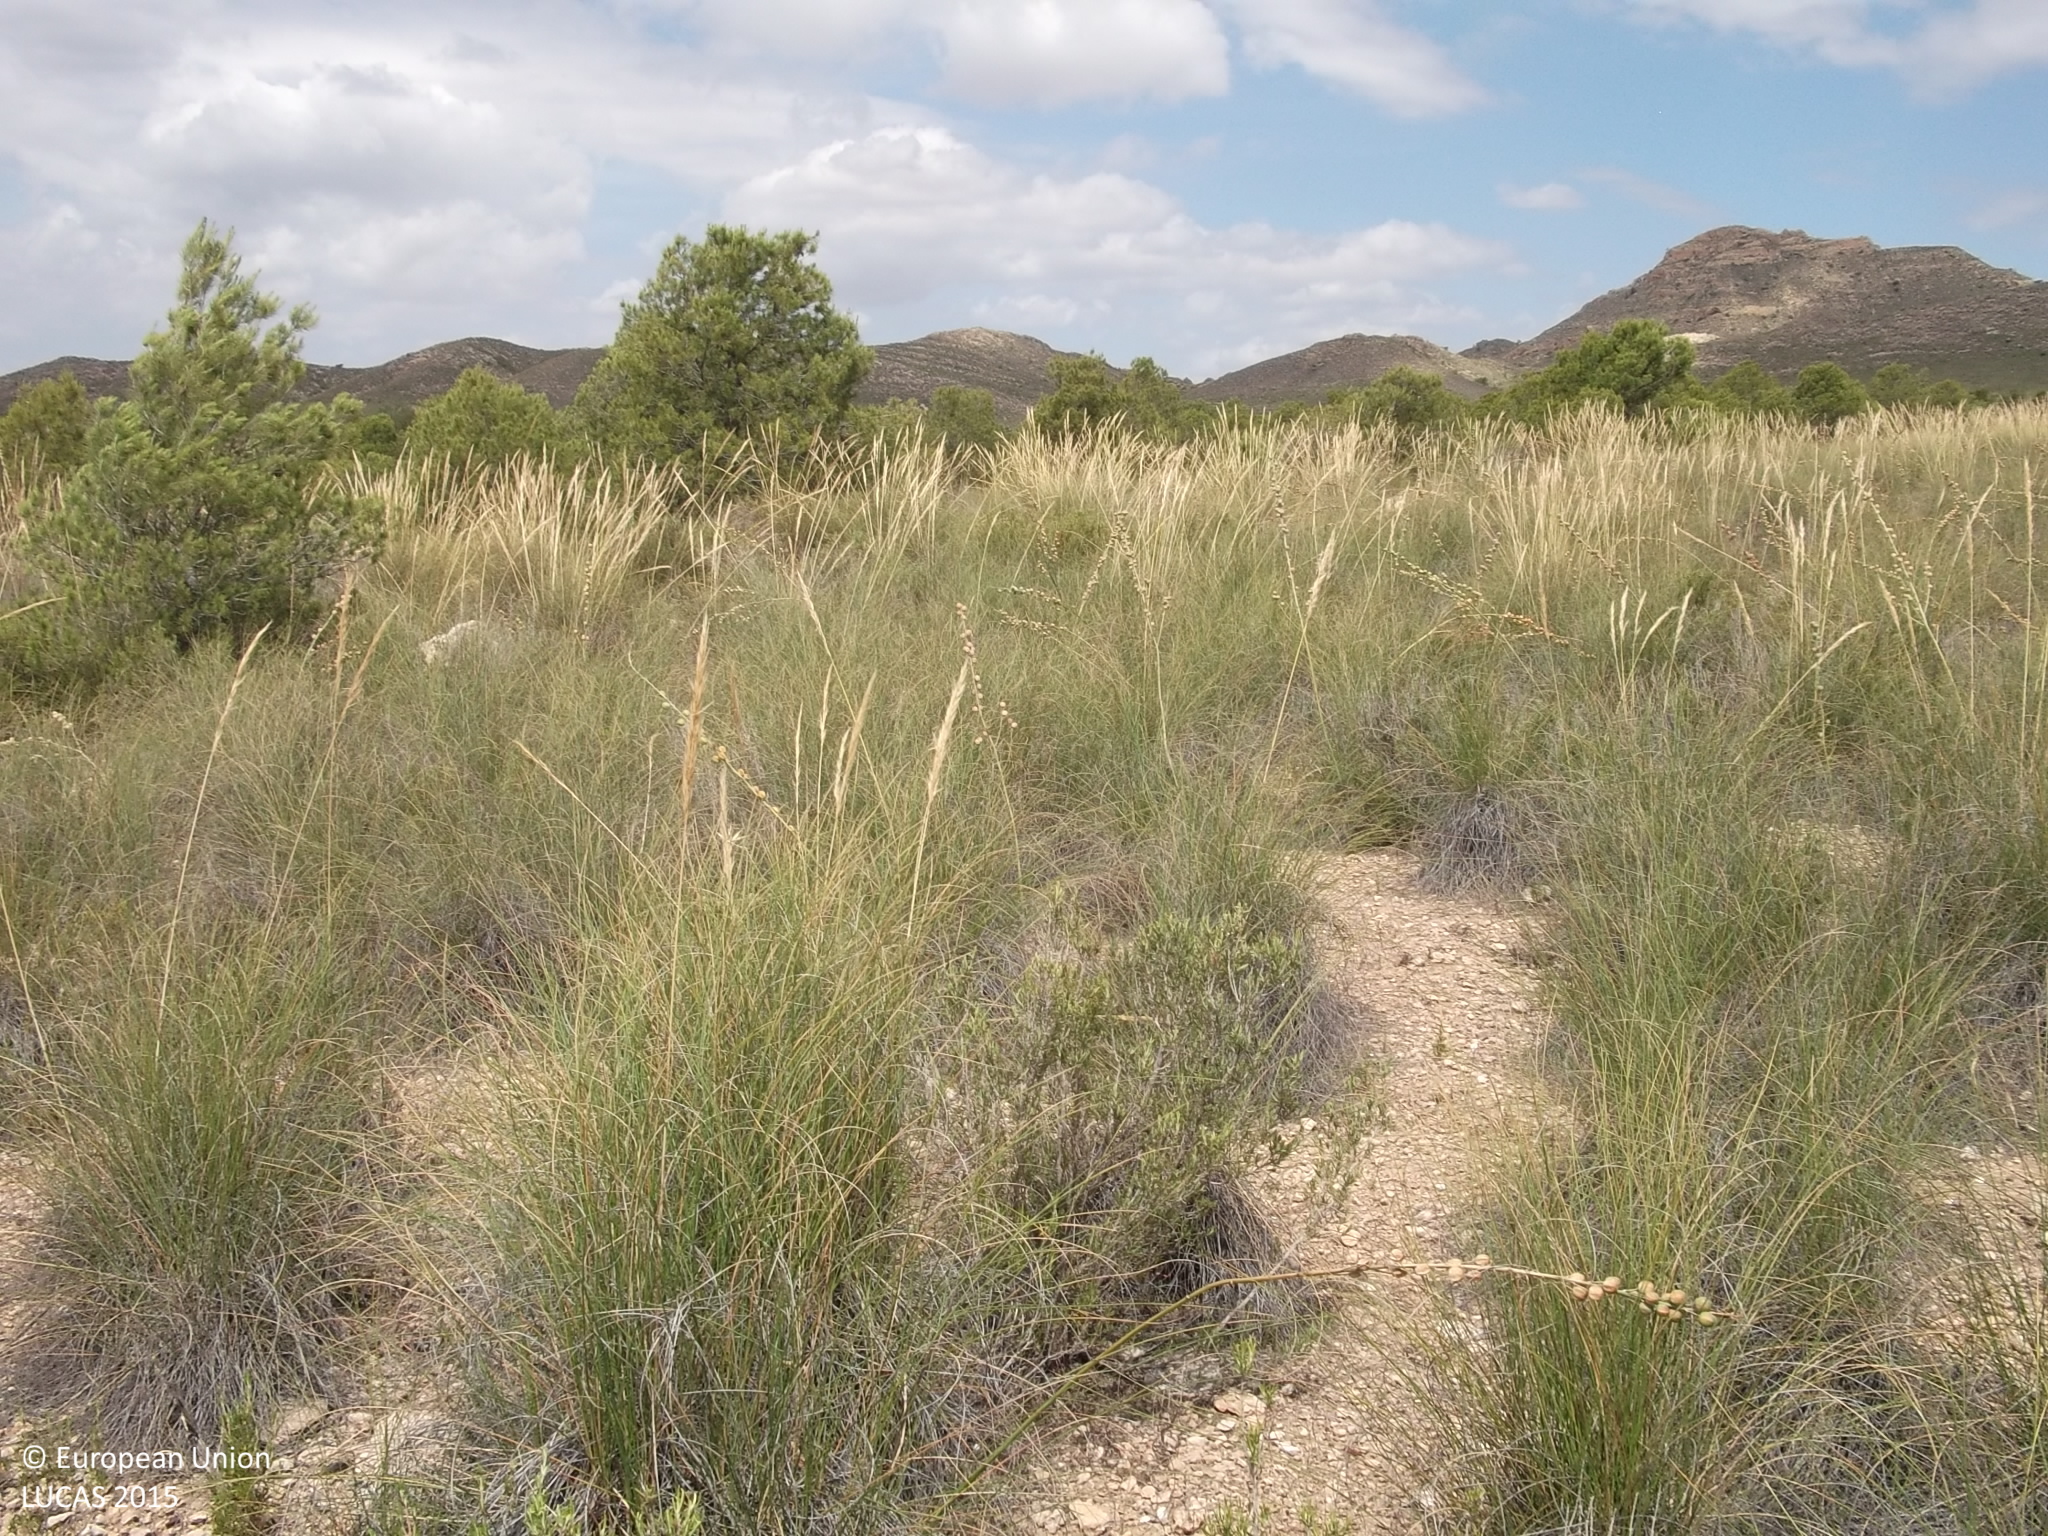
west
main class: Shrubland
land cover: Shrubland without tree cover
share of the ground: 25 - 50 %
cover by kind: shrubs 40 %, herbaceous plants 30 %, consolidated bare surface 30 %
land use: Semi-natural and natural areas not in use
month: May
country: ES
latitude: 38.3475
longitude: -1.4896
